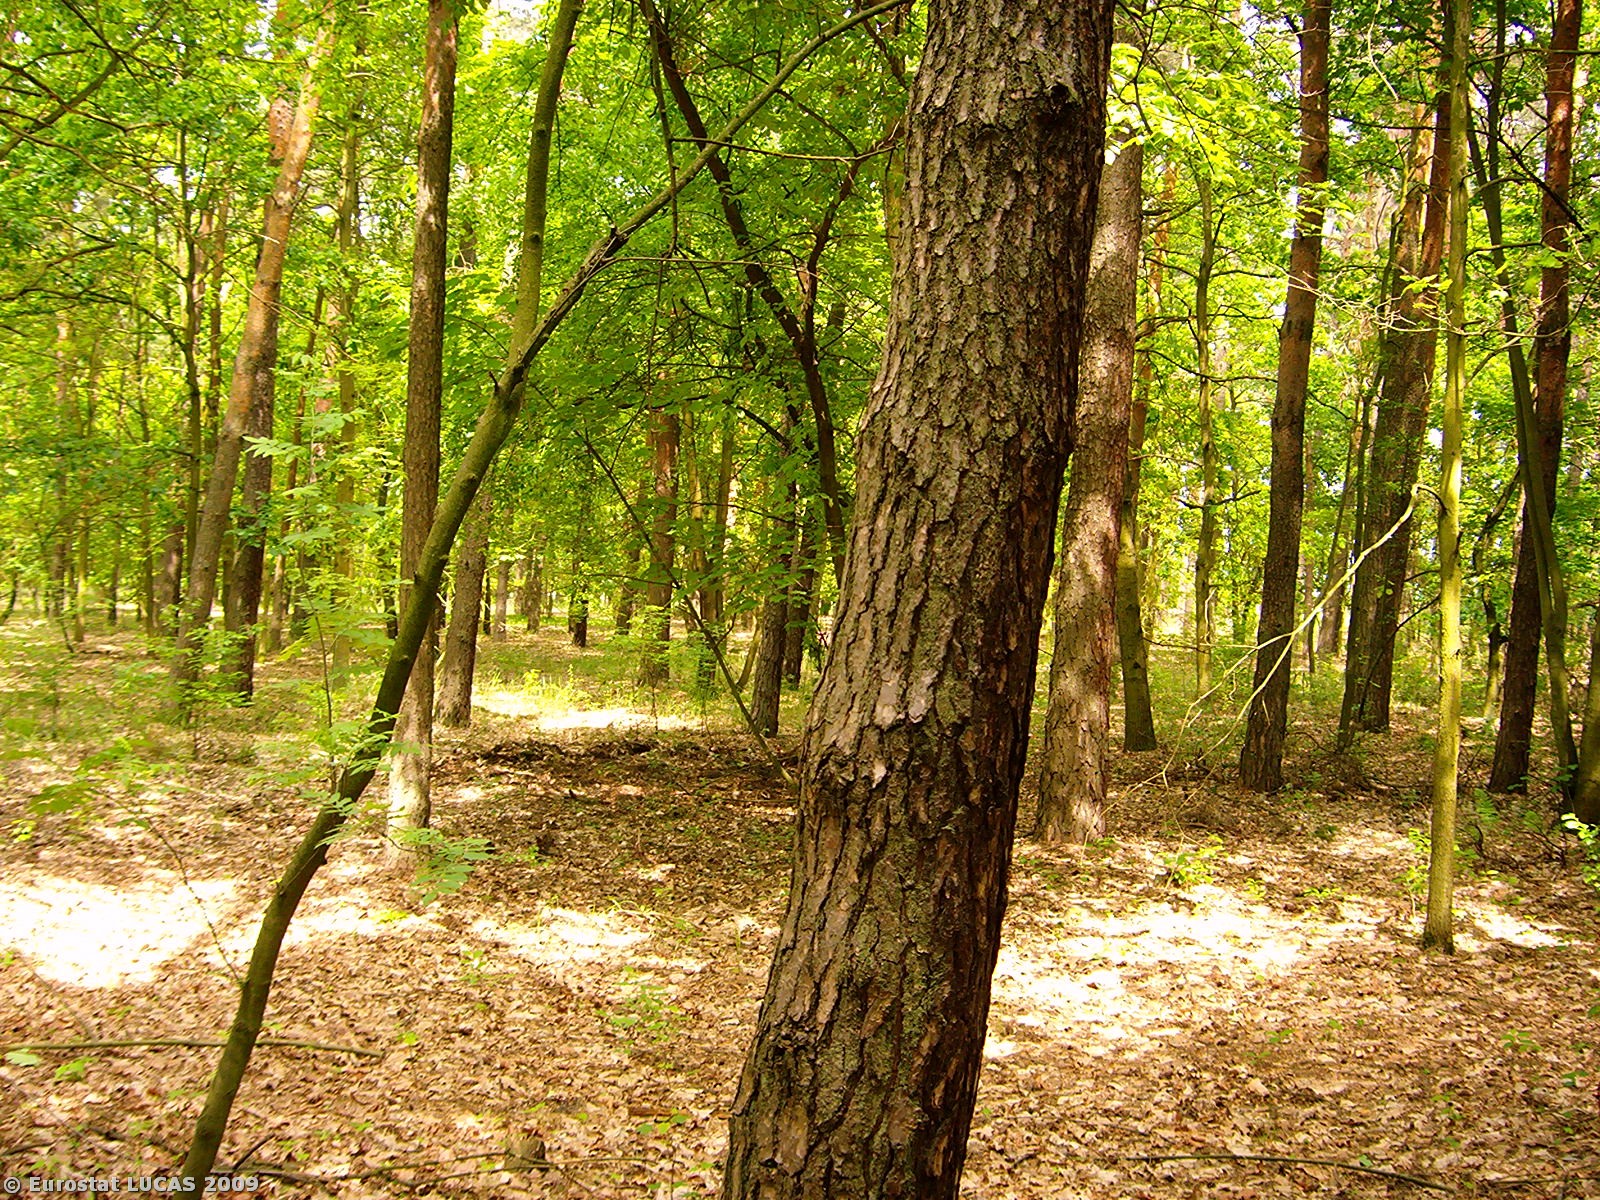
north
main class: Woodland
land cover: Mixed woodland
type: hemiboreal forest and nemoral coniferous forest and mixed broadleaved-coniferous forest
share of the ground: > 75 %
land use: Forestry
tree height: > 5 m
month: May
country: PL
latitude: 52.5327
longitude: 16.9825
